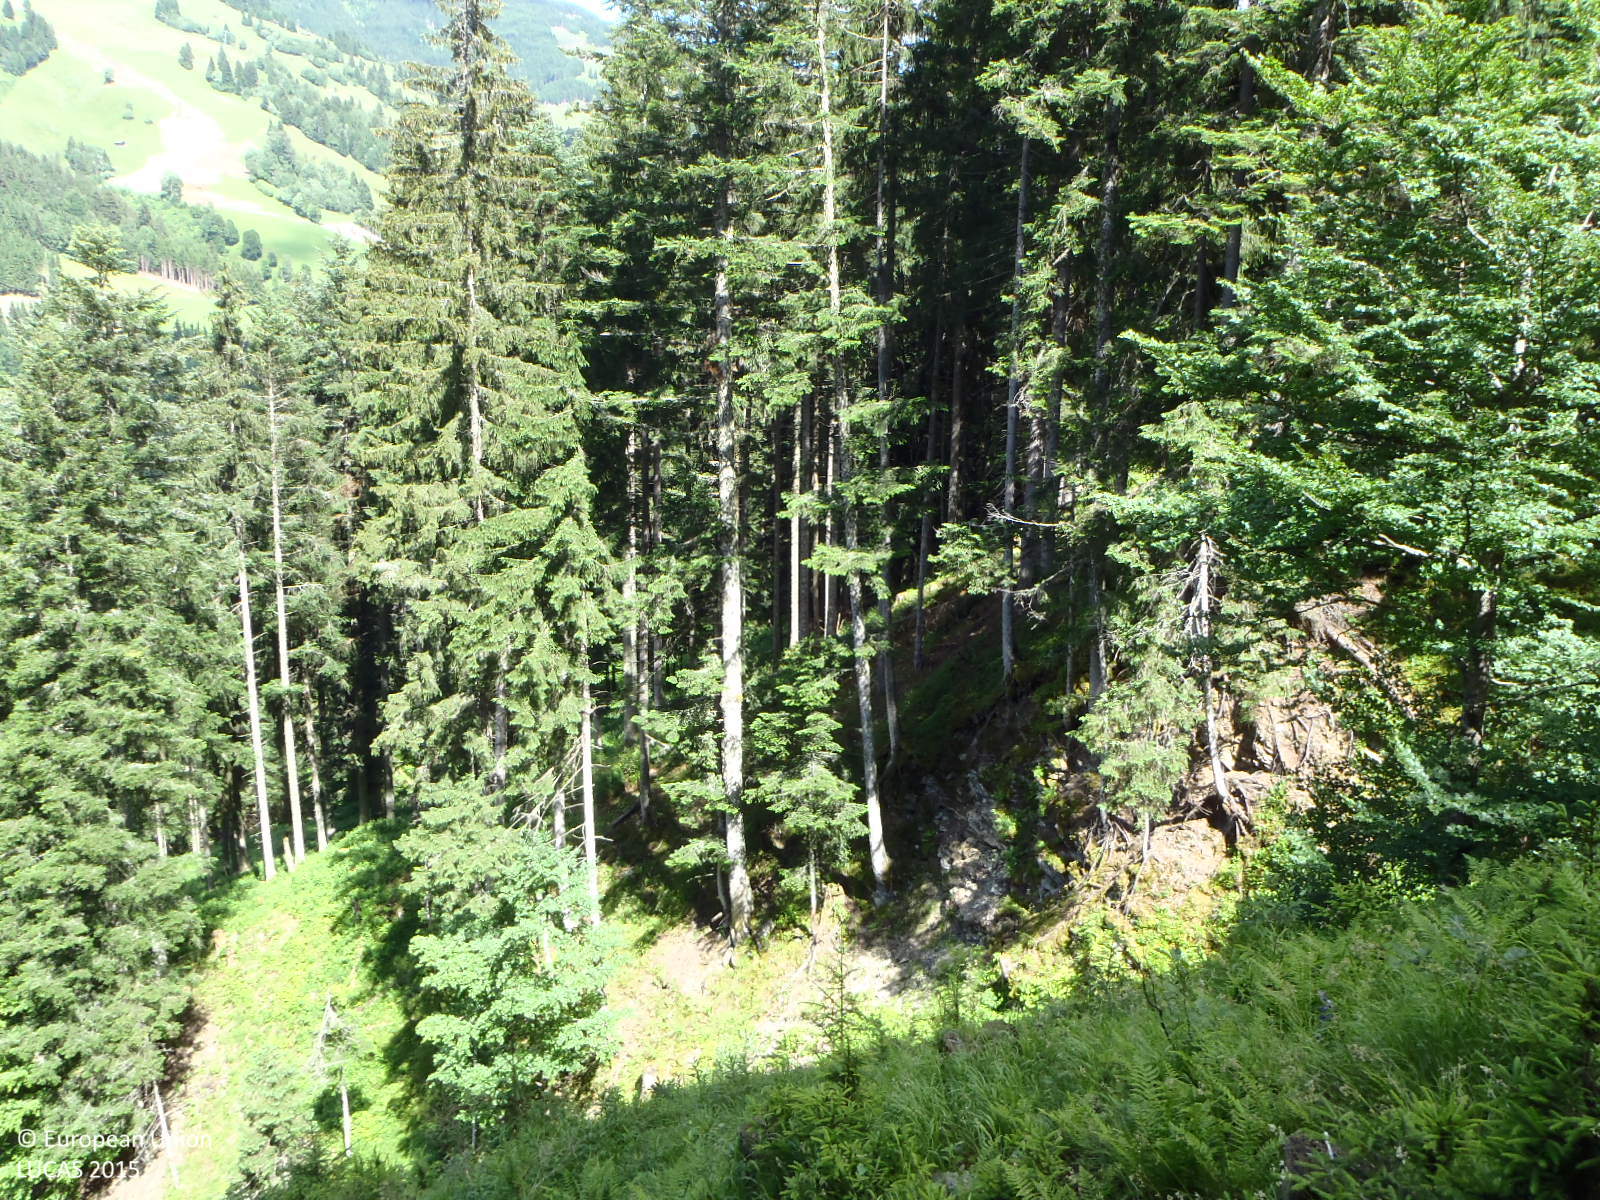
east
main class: Woodland
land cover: Spruce dominated coniferous woodland
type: alpine coniferous forest
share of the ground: 50 - 75 %
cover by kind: coniferous forest trees 60 %, broadleaved forest trees 10 %, shrubs 10 %, herbaceous plants 10 %, lichens and mosses 10 %
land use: Forestry
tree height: > 5 m
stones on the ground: < 10 %
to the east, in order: Spruce dominated coniferous woodland; Rivers and streams; Spruce dominated coniferous woodland; Grassland with sparse tree/shrub cover; Spruce dominated coniferous woodland; Rivers and streams; Spruce dominated coniferous woodland; Fences; Grassland without tree/shrub cover
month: June
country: AT
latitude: 47.3811
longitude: 12.6605
